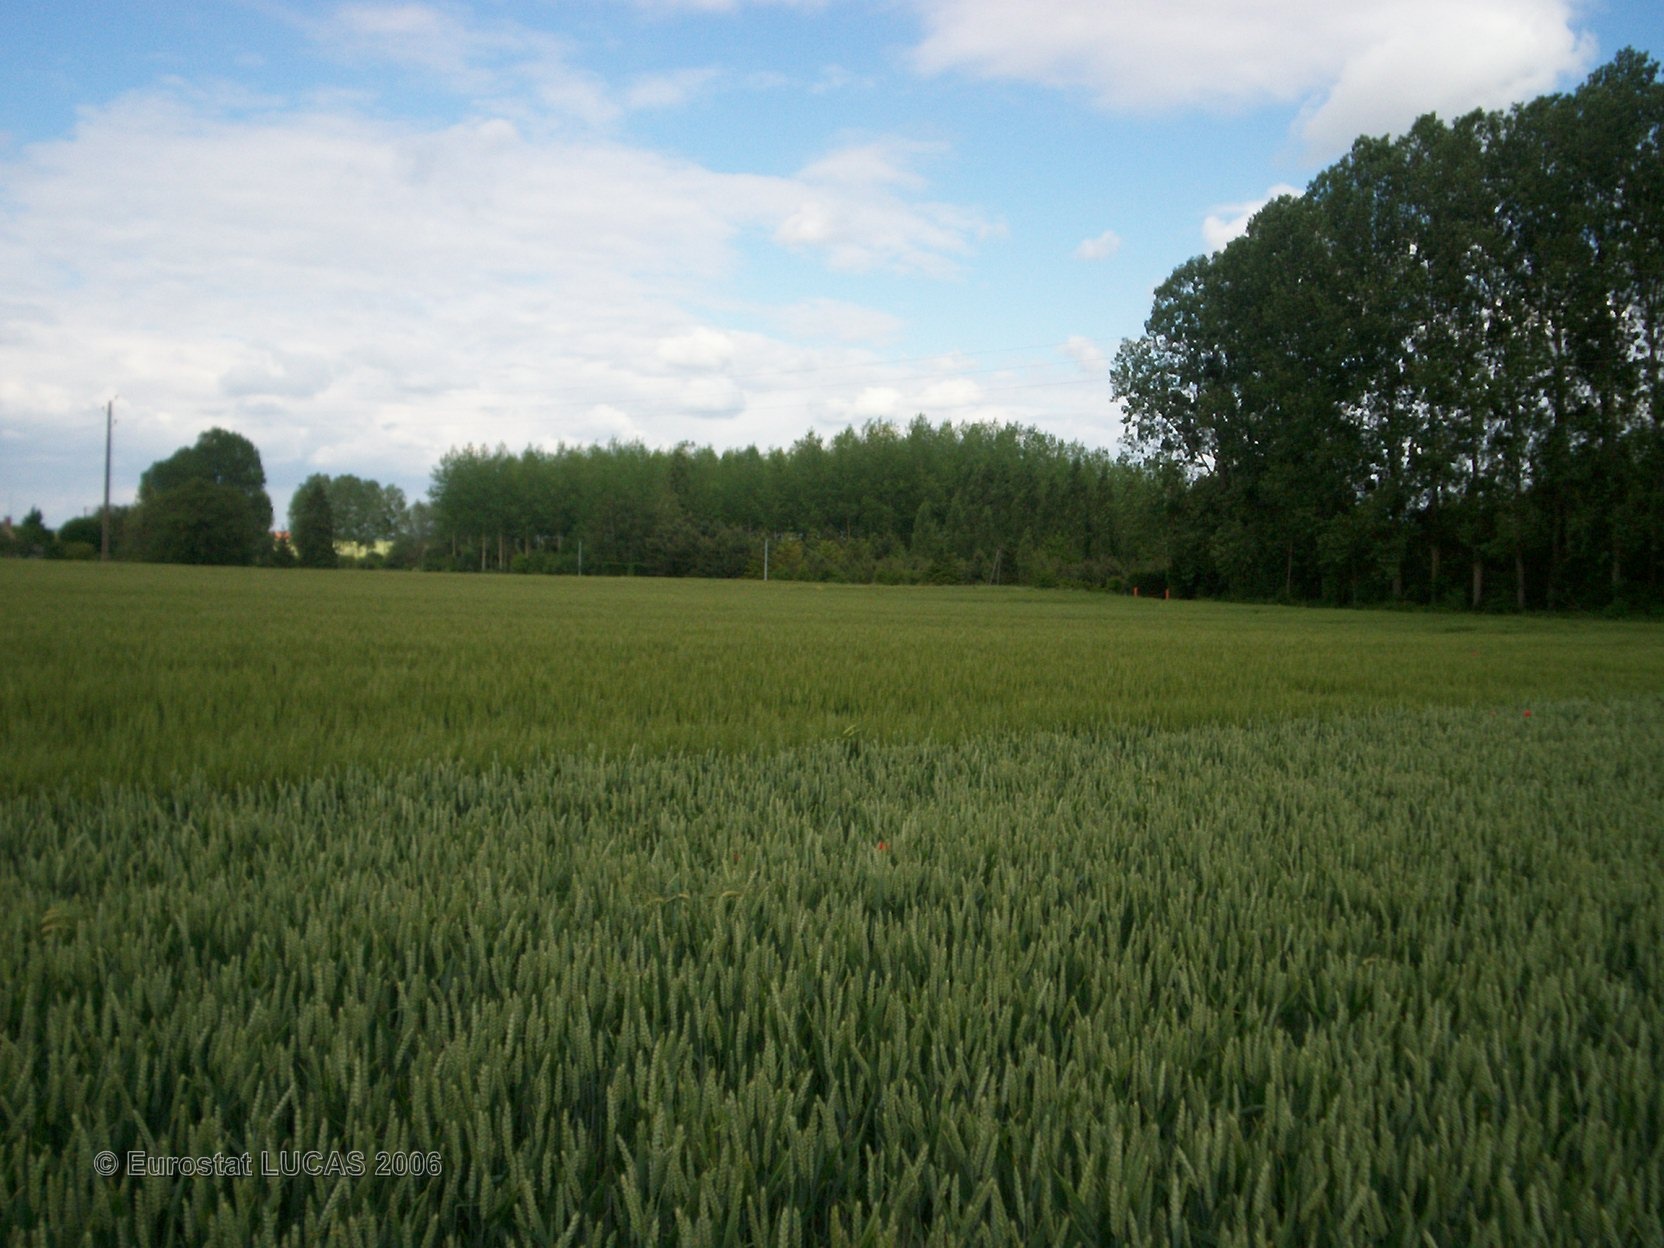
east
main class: Cropland
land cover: Common wheat
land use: Agriculture (excluding fallow land and kitchen gardens)
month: May
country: FR
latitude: 46.9926
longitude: 1.5331
